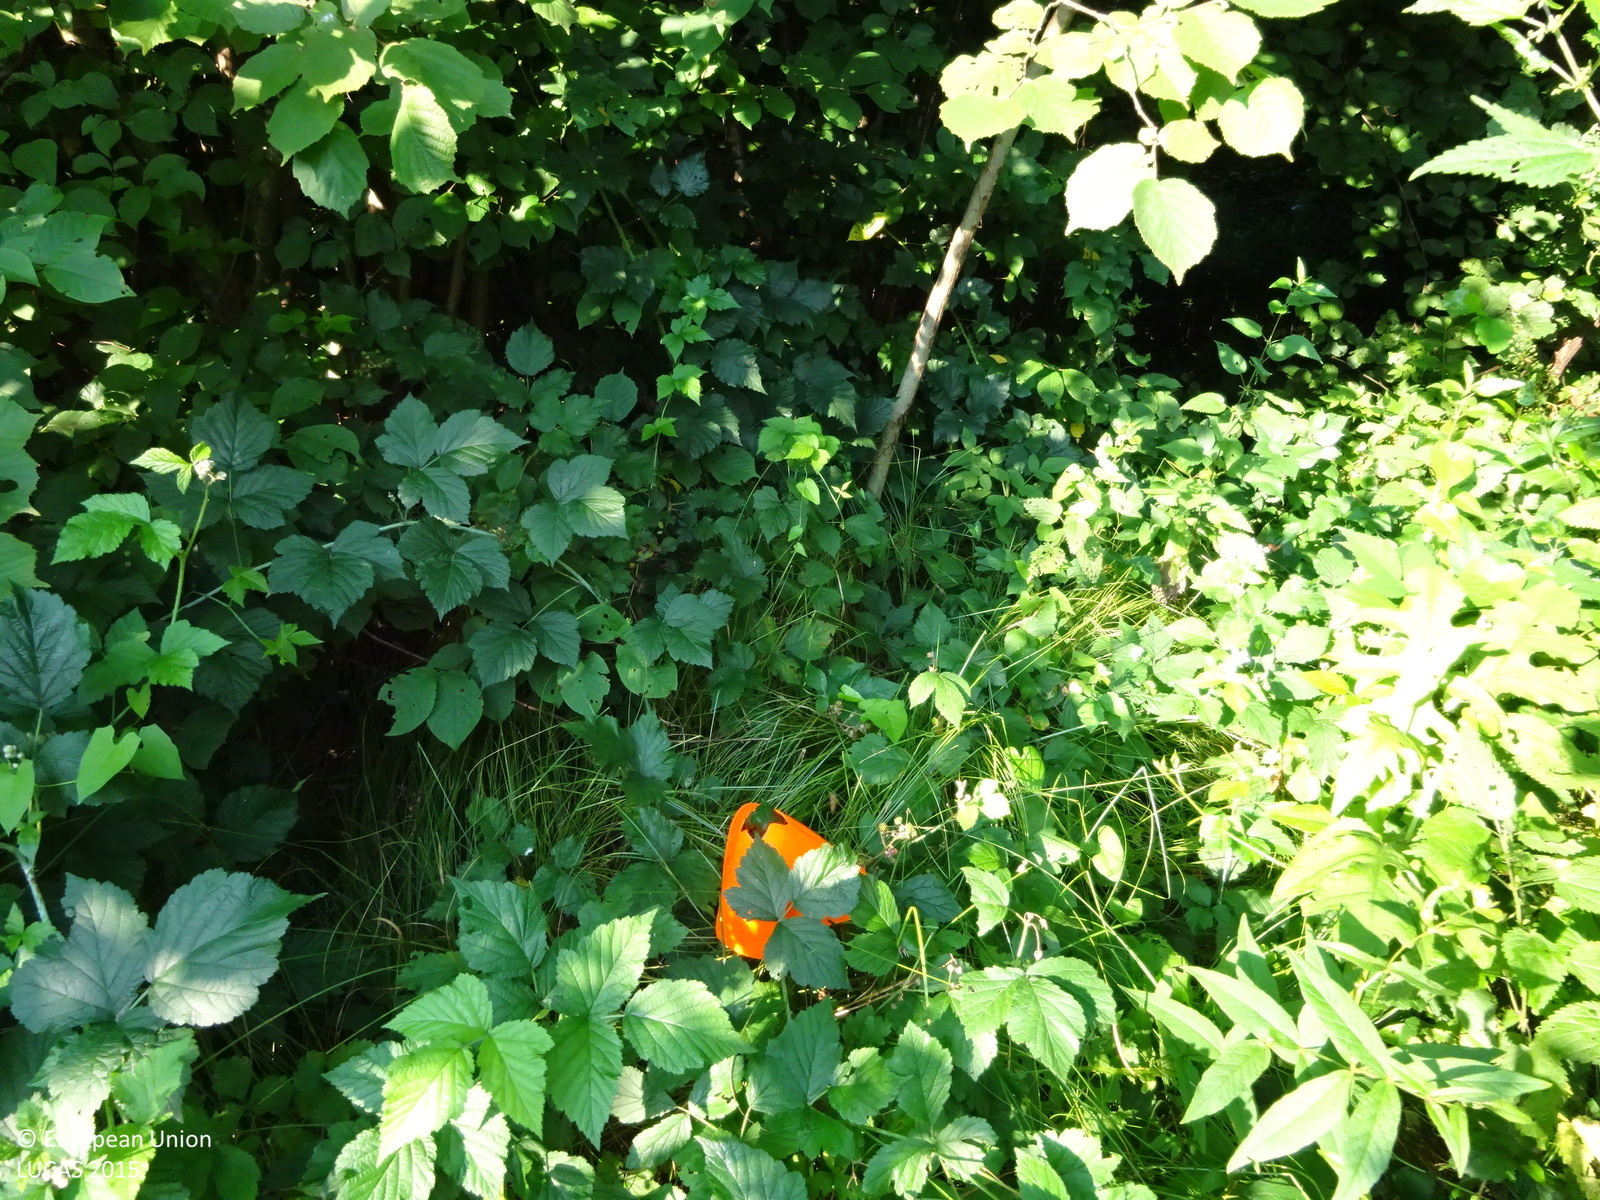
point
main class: Shrubland
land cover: Shrubland with sparse tree cover
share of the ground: 10 - 25 %
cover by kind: shrubs 65 %, herbaceous plants 30 %, broadleaved forest trees 5 %
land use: Abandoned areas
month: July
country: AT
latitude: 46.9175
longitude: 15.4226
